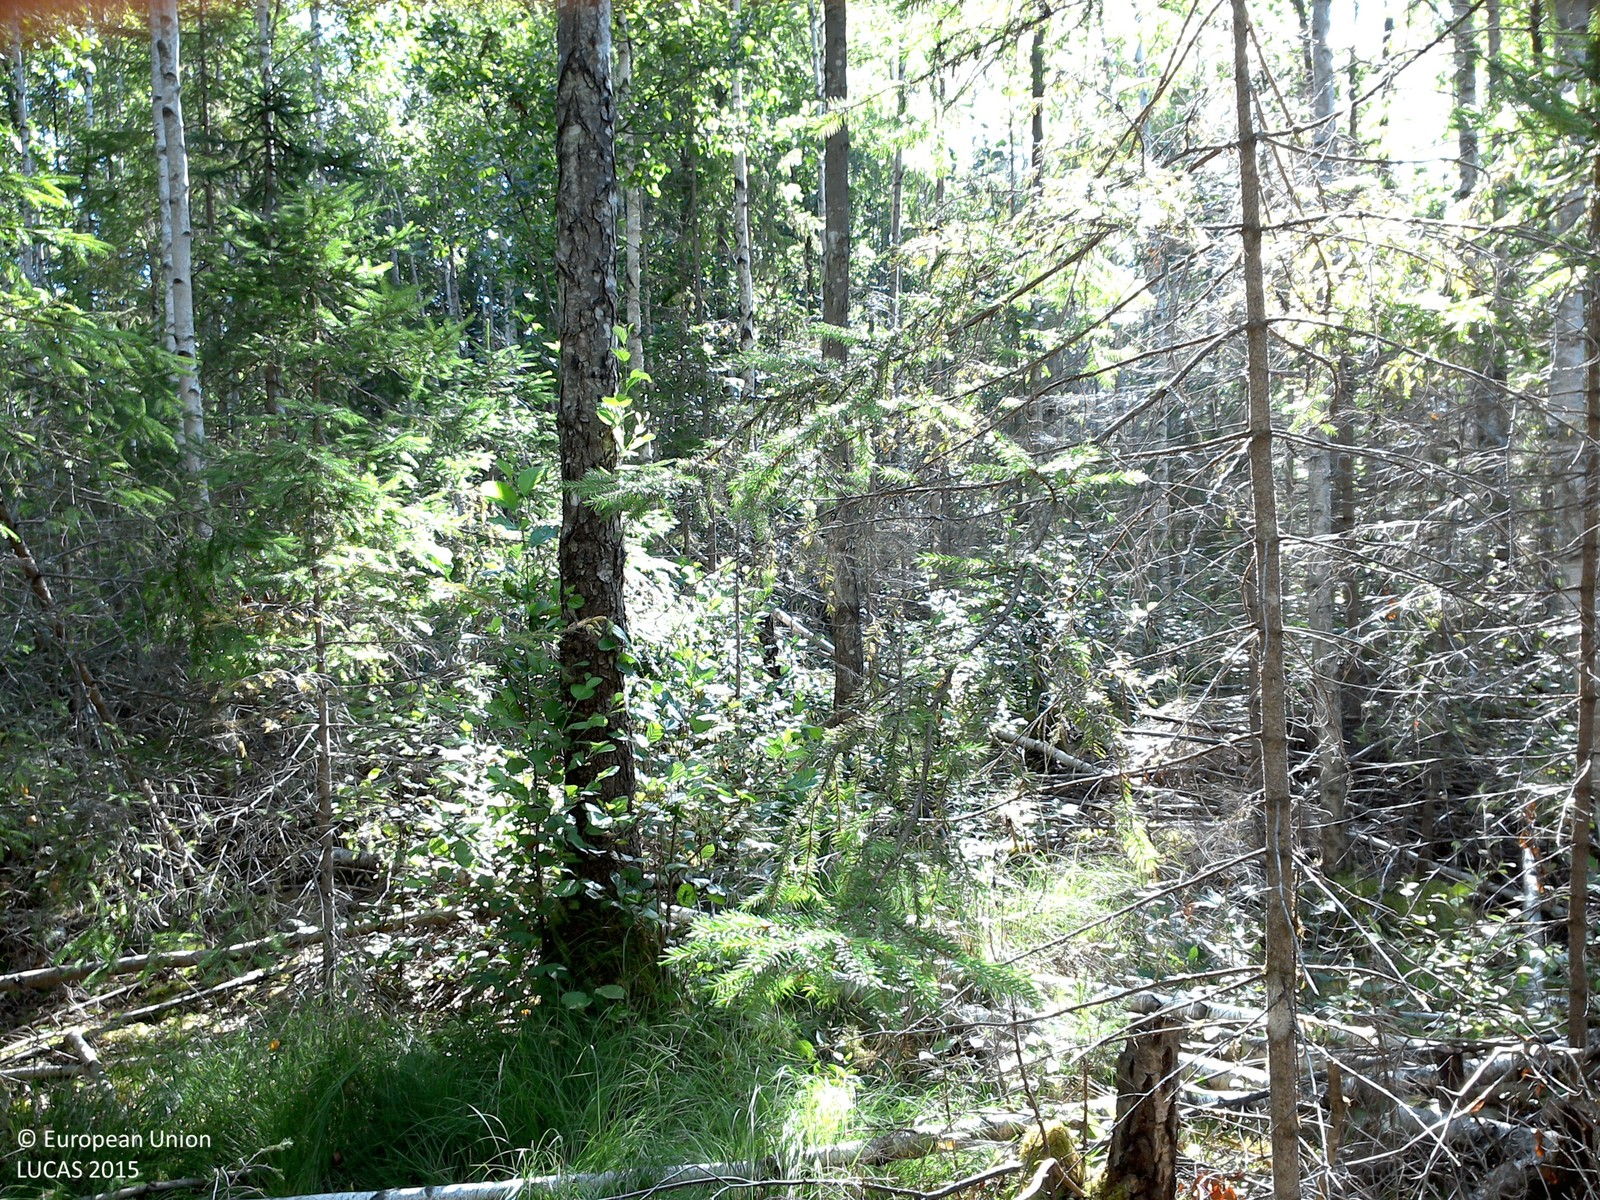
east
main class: Woodland
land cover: Broadleaved woodland
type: hemiboreal forest and nemoral coniferous forest and mixed broadleaved-coniferous forest
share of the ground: 50 - 75 %
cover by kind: broadleaved forest trees 65 %, herbaceous plants 25 %, lichens and mosses 10 %
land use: Forestry
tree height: > 5 m
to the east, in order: Broadleaved woodland; Ditches and canals; Broadleaved woodland; Other leguminous and mixtures for fodder
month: July
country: SE
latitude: 58.2788
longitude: 15.2636
